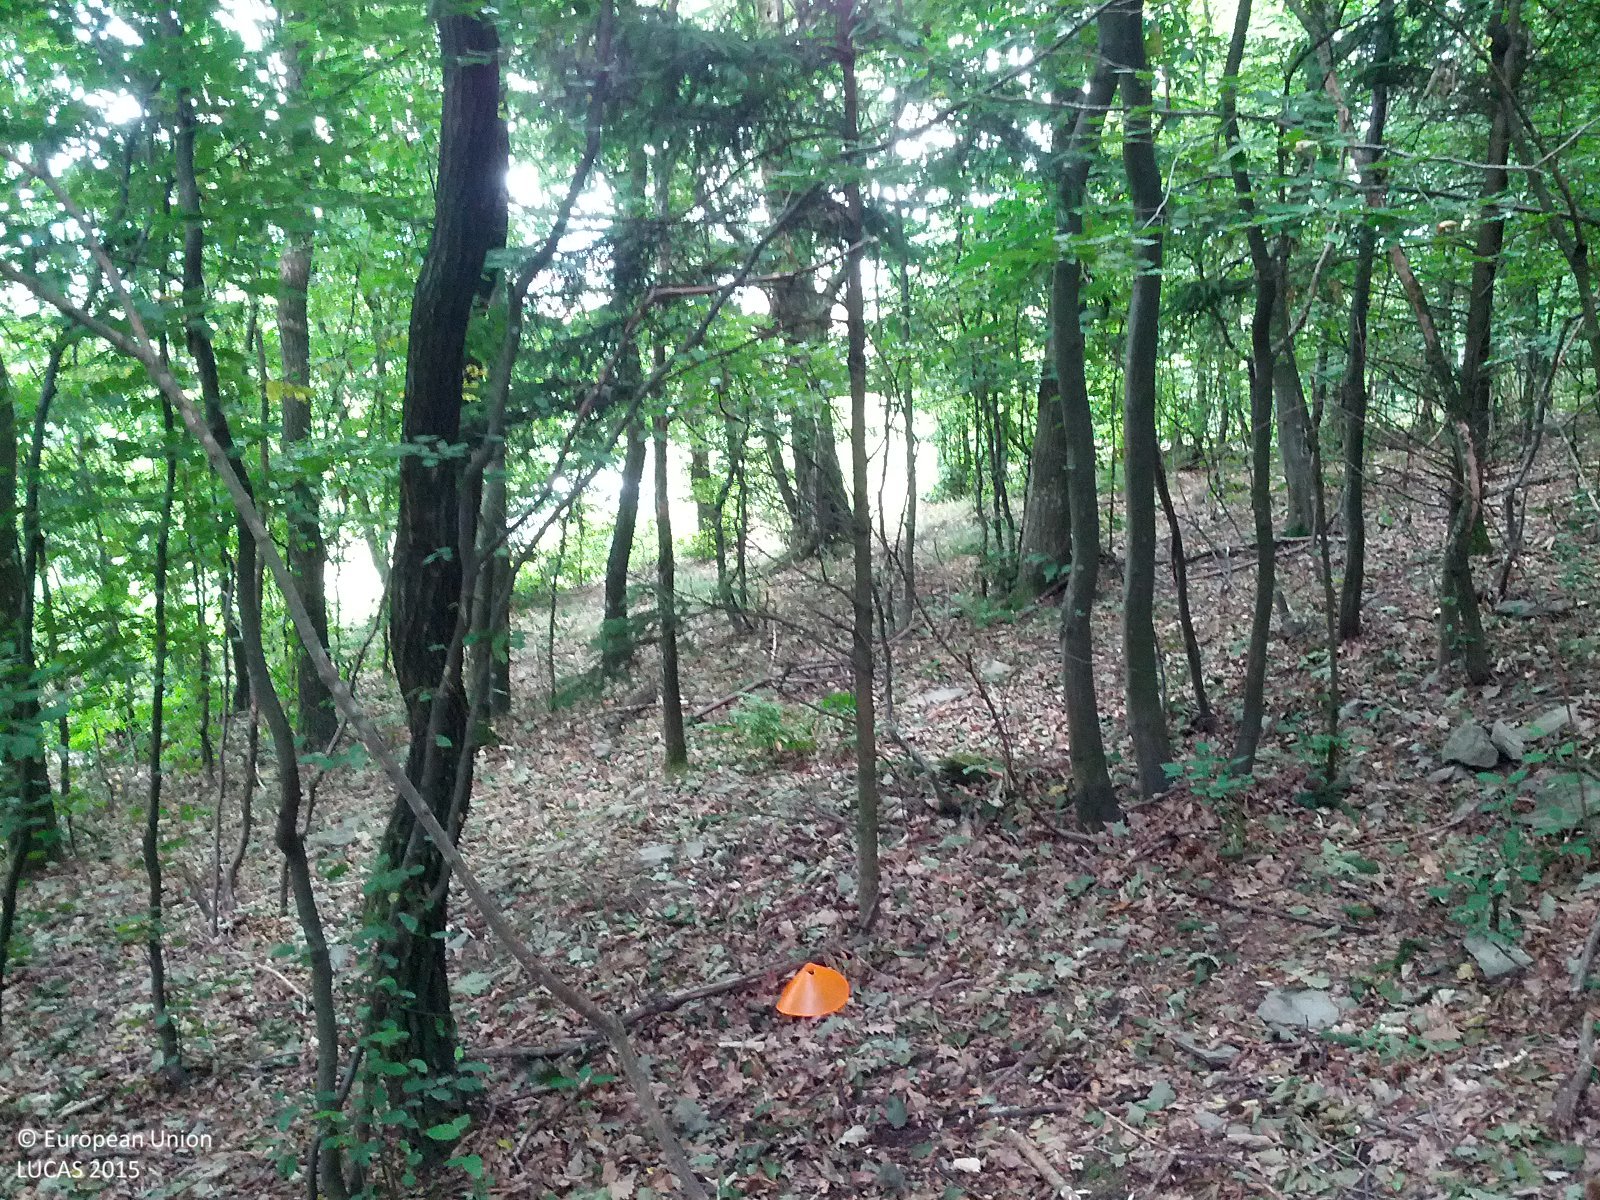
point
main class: Woodland
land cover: Spruce dominated mixed woodland
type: alpine coniferous forest
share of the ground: > 75 %
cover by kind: coniferous forest trees 55 %, broadleaved forest trees 35 %, shrubs 5 %, unconsolidated bare surface 5 %
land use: Forestry
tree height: > 5 m
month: July
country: AT
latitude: 47.3143
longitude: 16.4190
